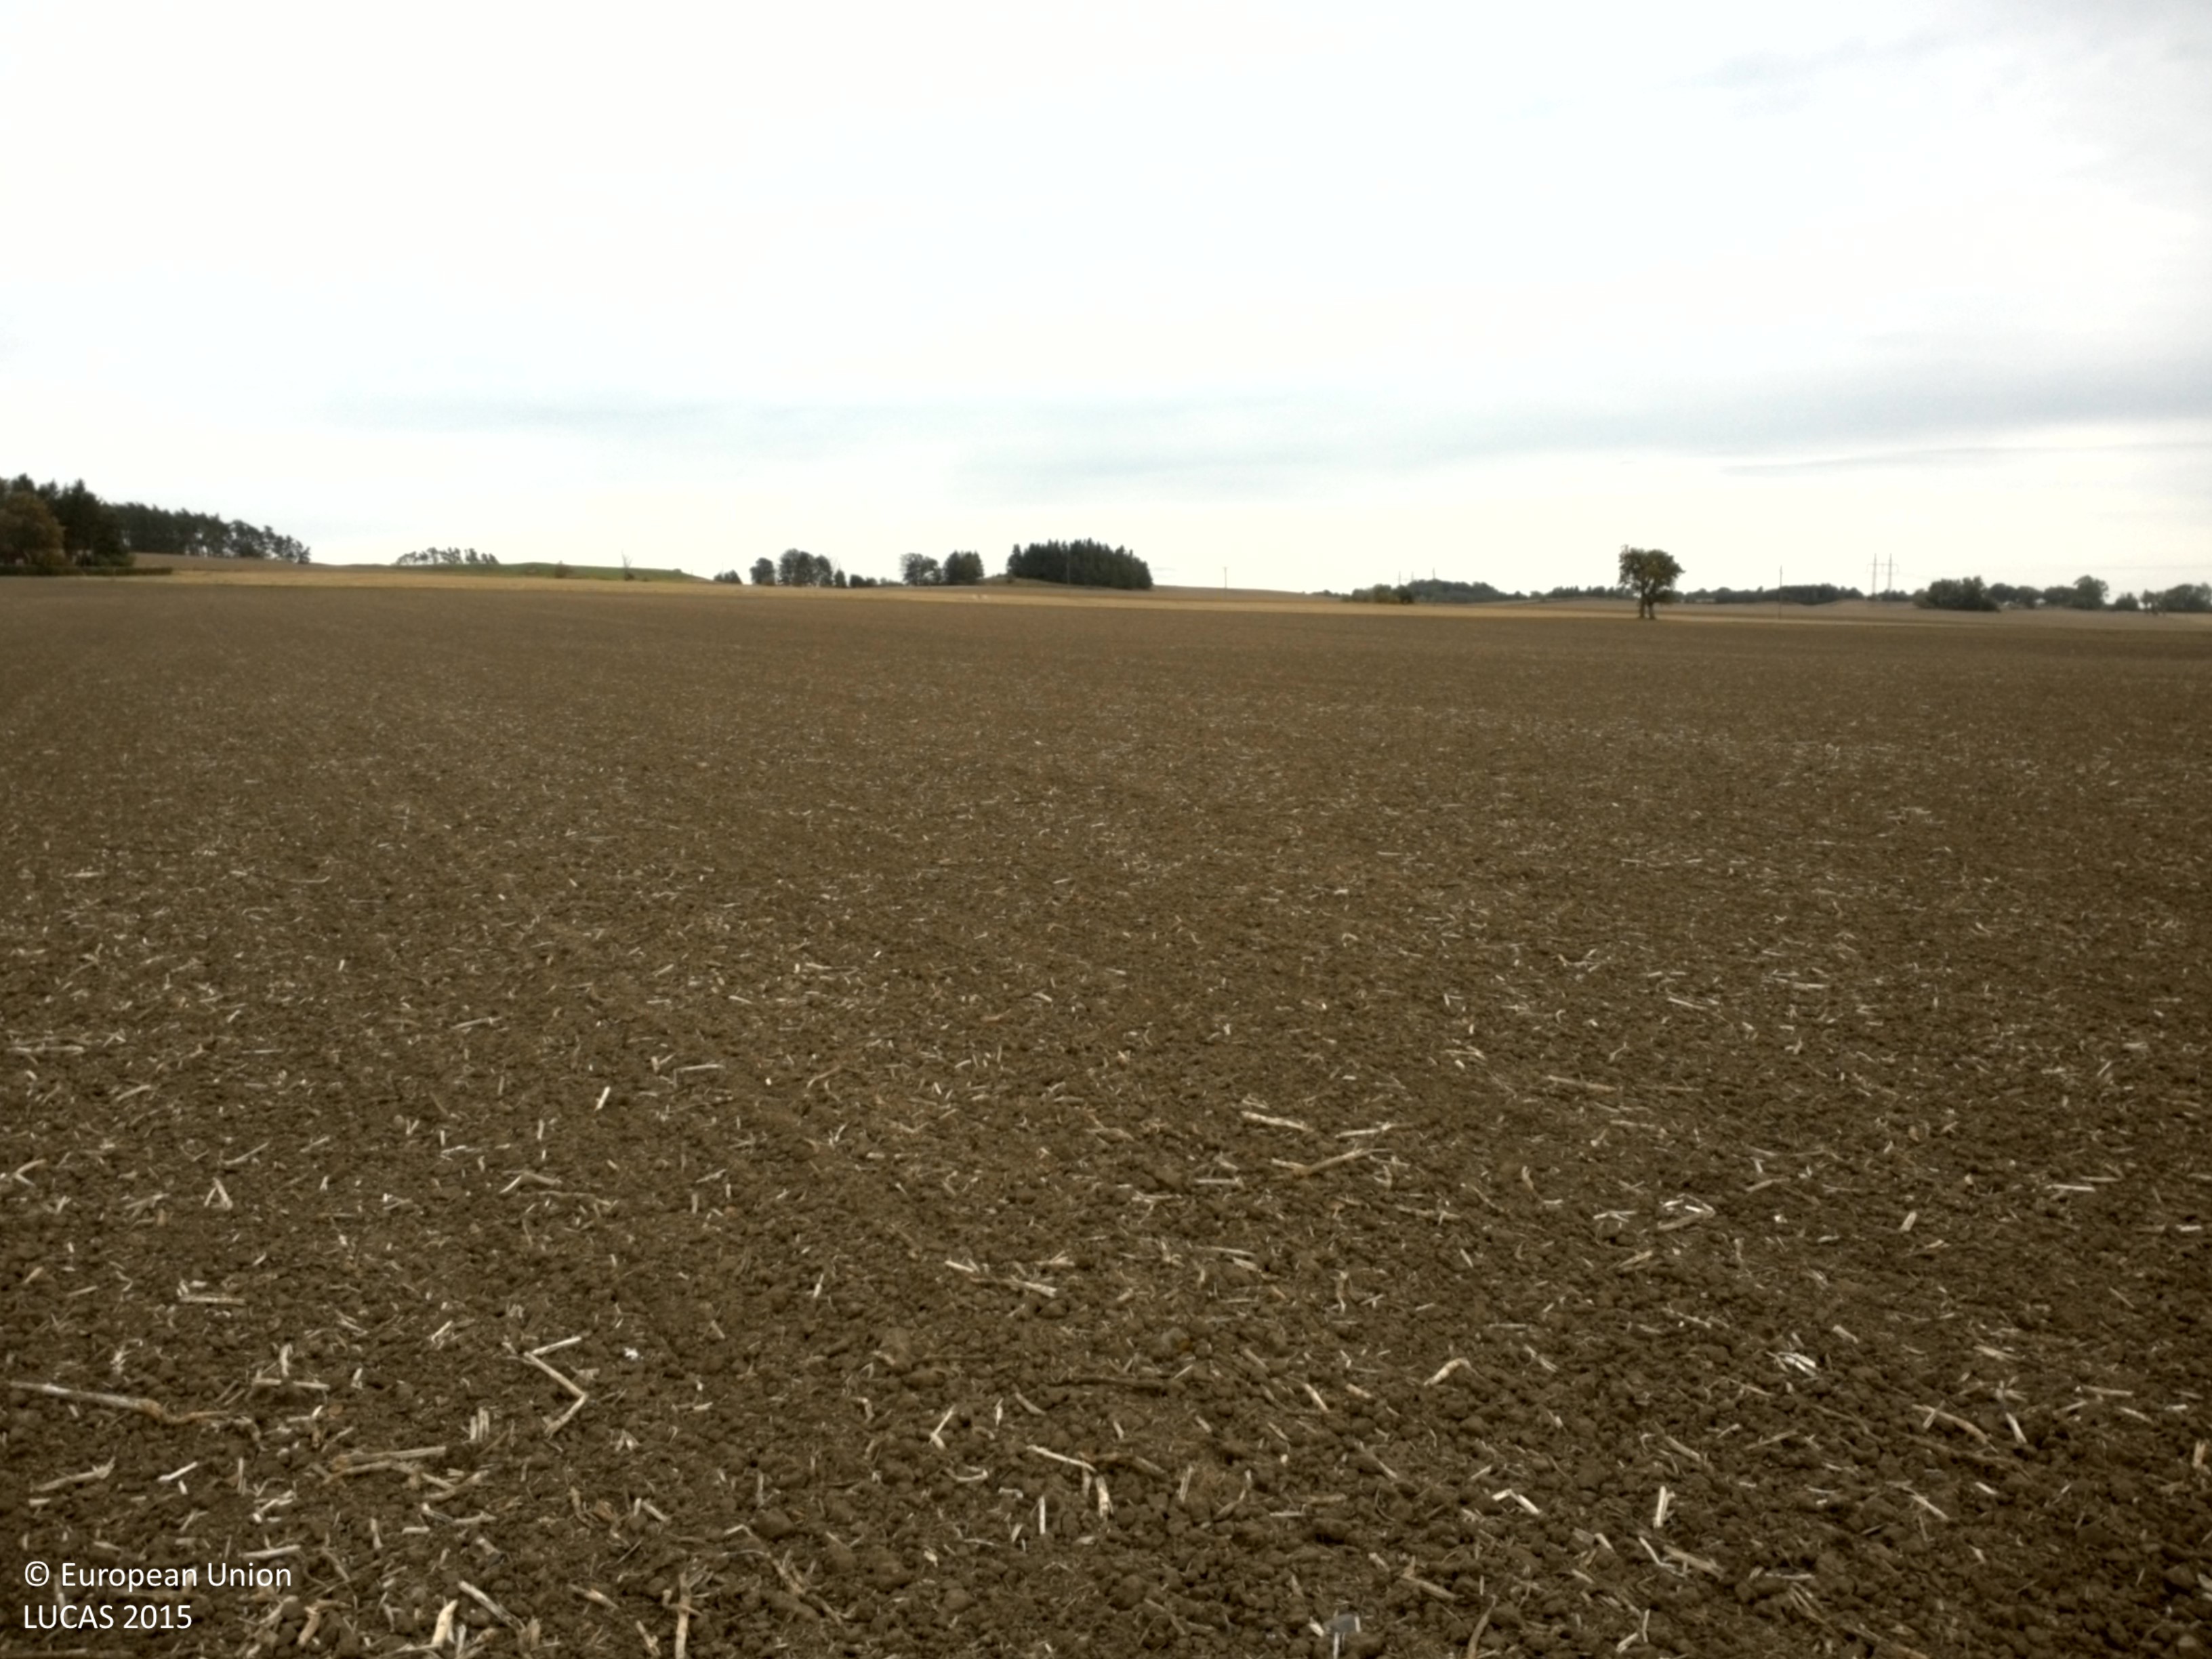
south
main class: Cropland
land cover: Common wheat
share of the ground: < 10 %
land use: Agriculture (excluding fallow land and kitchen gardens)
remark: Tilled/Sowed
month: October
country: SE
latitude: 55.8450
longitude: 13.0801
